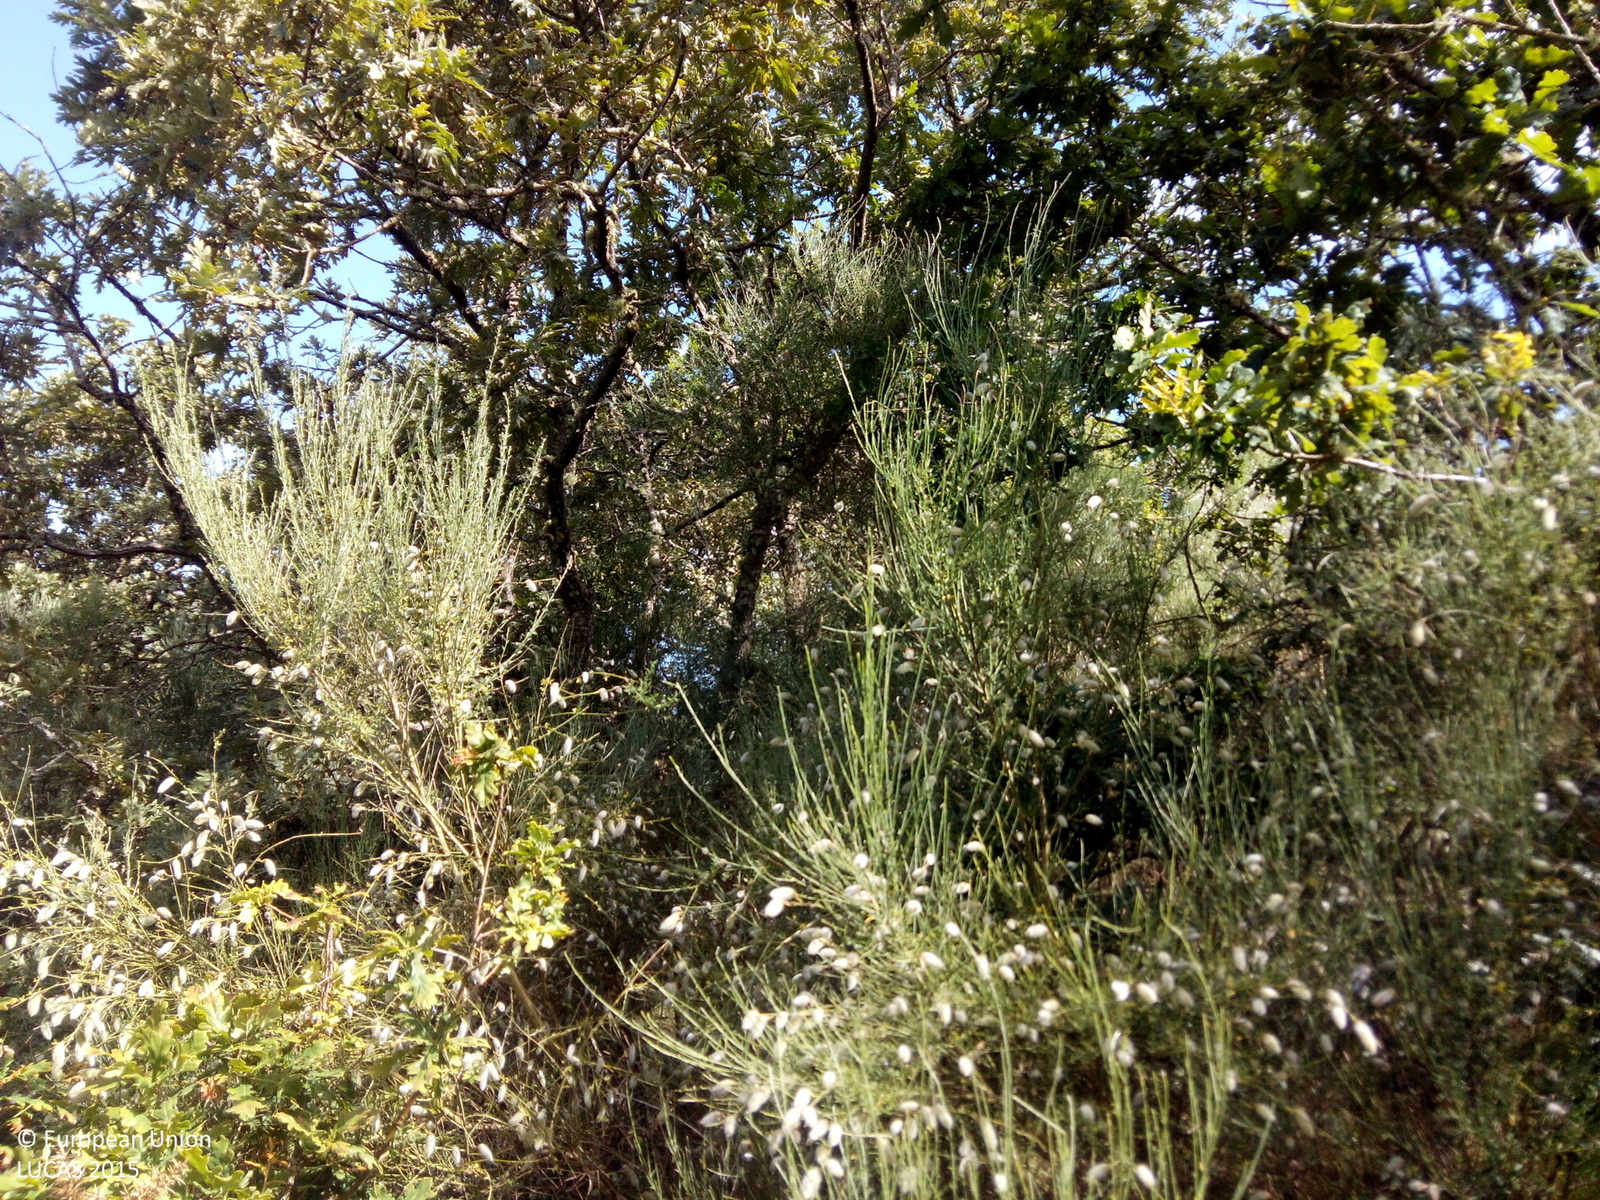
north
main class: Woodland
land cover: Other mixed woodland
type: acidophilous oak and oak-birch forest
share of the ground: > 75 %
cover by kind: shrubs 75 %, broadleaved forest trees 15 %, coniferous forest trees 10 %
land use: Abandoned areas
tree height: > 5 m
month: July
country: ES
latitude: 42.3615
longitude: -8.2653
